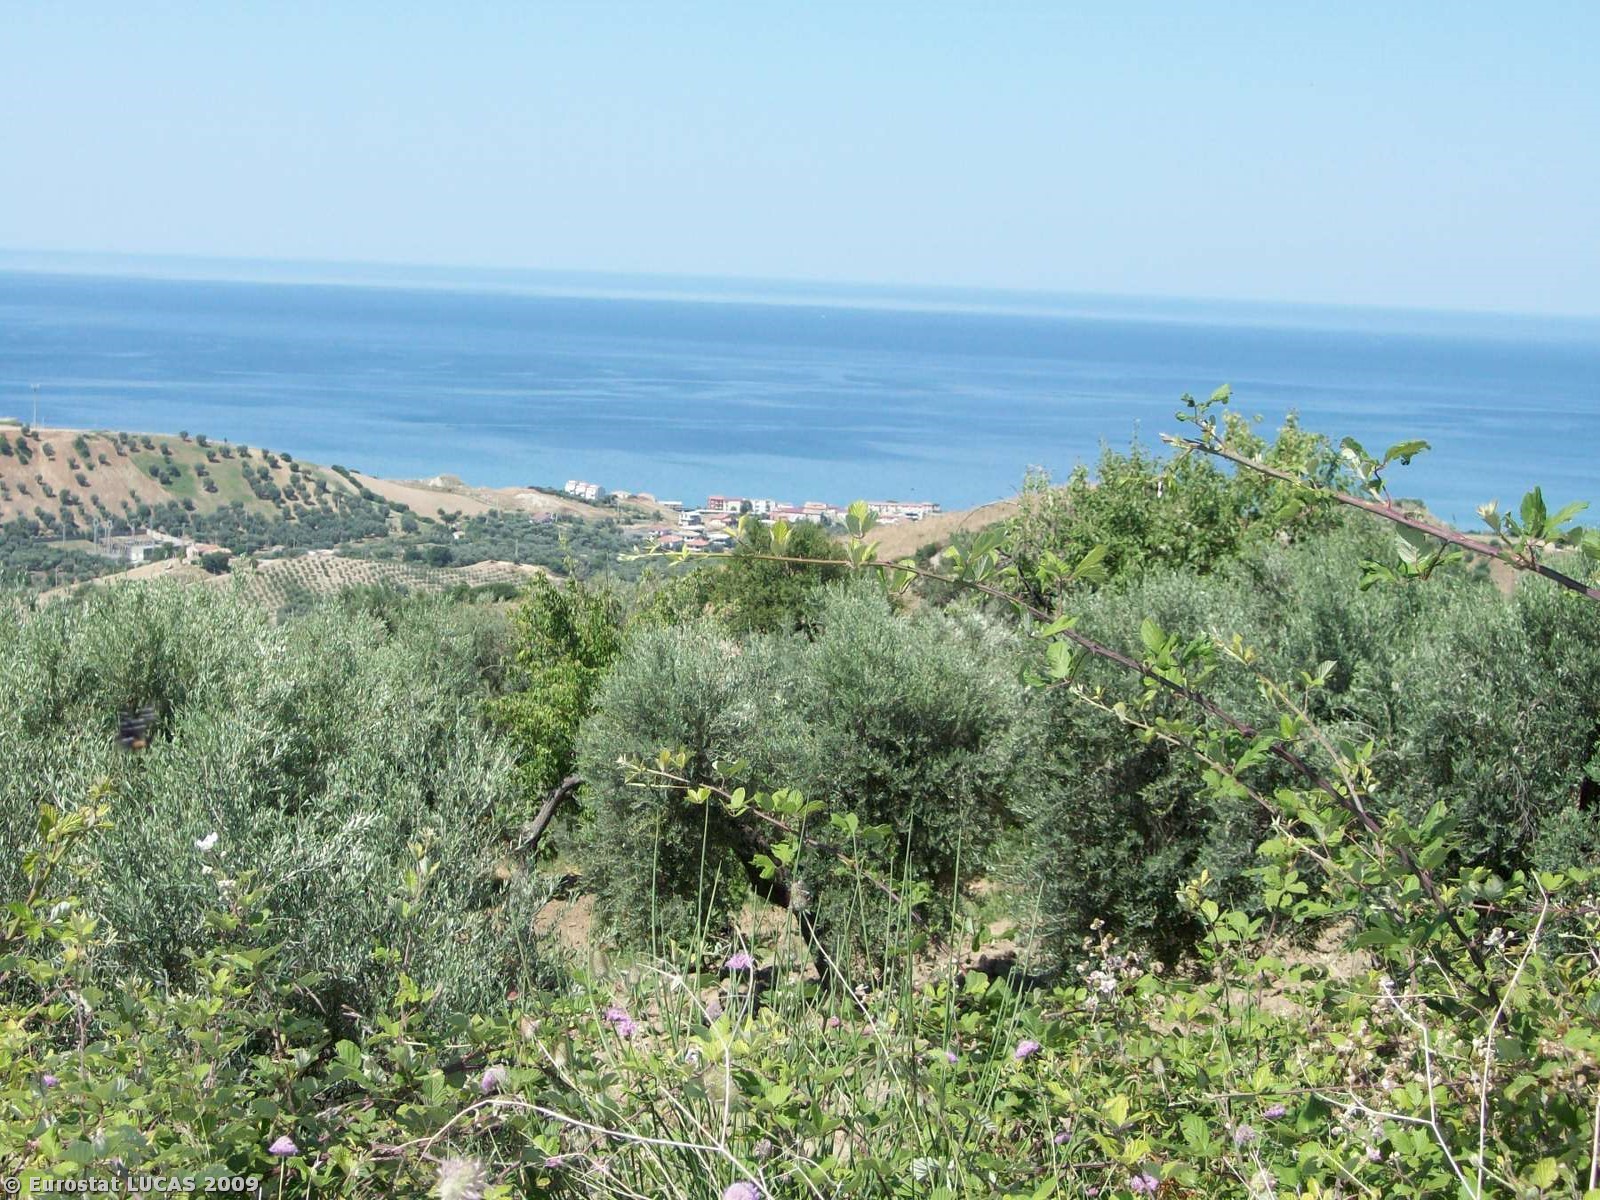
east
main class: Shrubland
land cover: Shrubland with sparse tree cover
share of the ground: > 75 %
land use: Unused
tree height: > 5 m
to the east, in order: Shrubland with sparse tree cover; Shruby margins; Bare land; Shruby margins; Artificial constructions; Paved roads, cycling and walking lanes; Shruby margins; Fences; Shruby margins; Bare land; Olive groves; Shruby margins; Fences; Shruby margins; Olive groves; Bare land
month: June
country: IT
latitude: 39.4966
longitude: 16.9115
